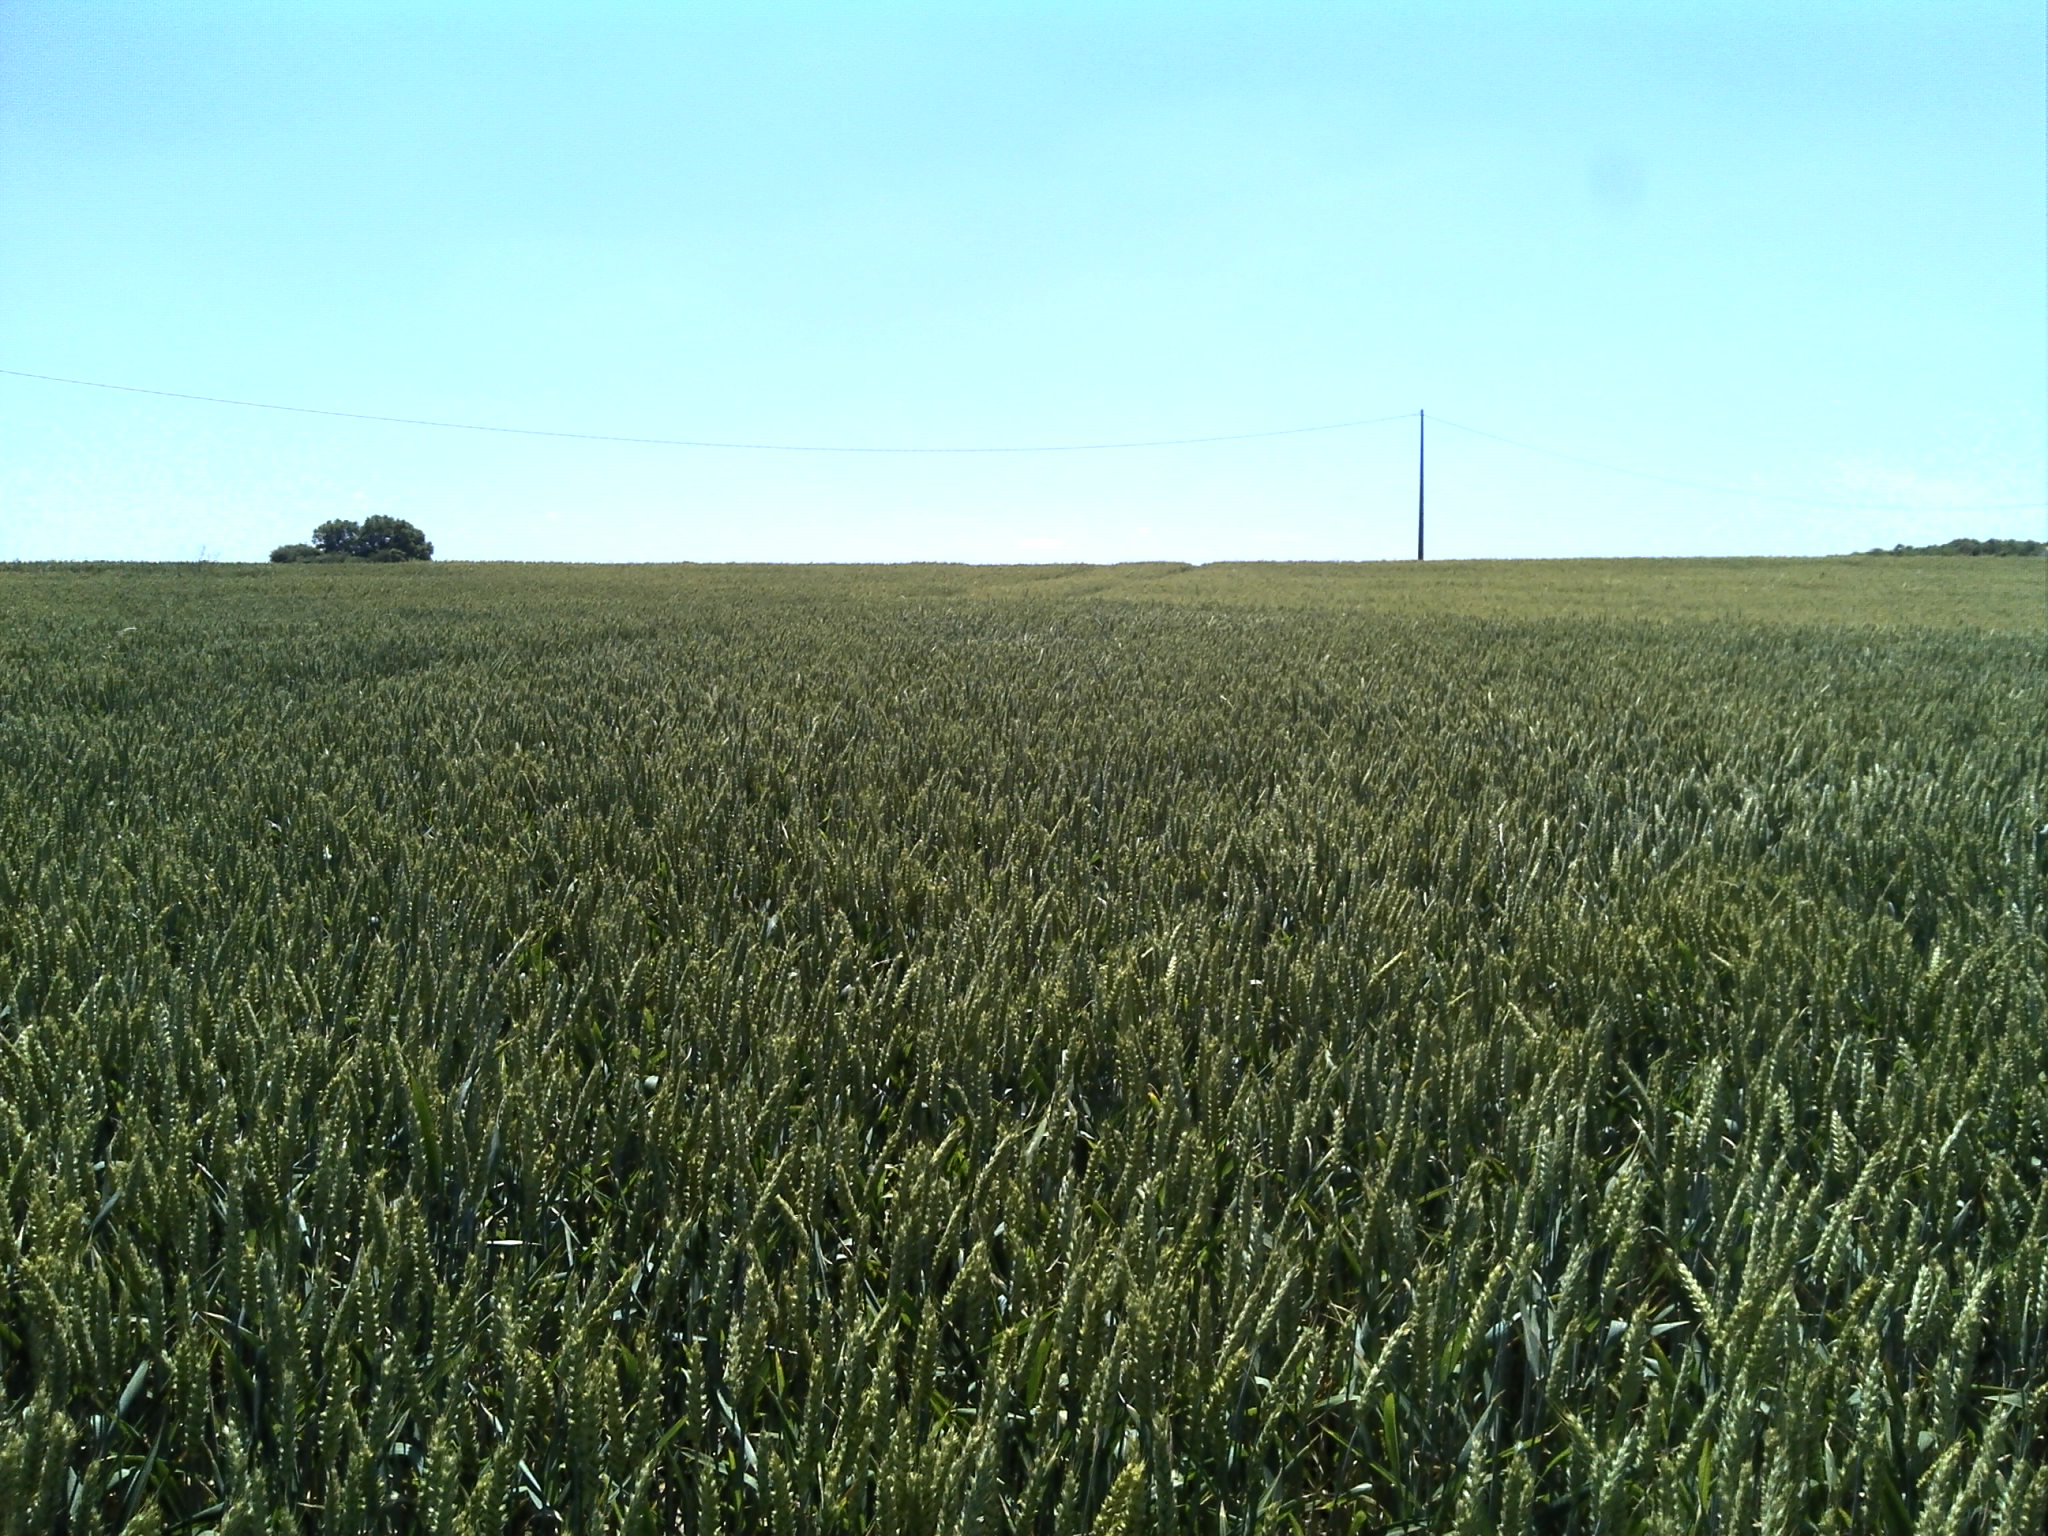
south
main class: Cropland
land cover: Common wheat
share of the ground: > 75 %
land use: Agriculture (excluding fallow land and kitchen gardens)
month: June
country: FR
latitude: 47.1651
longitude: 1.4254
